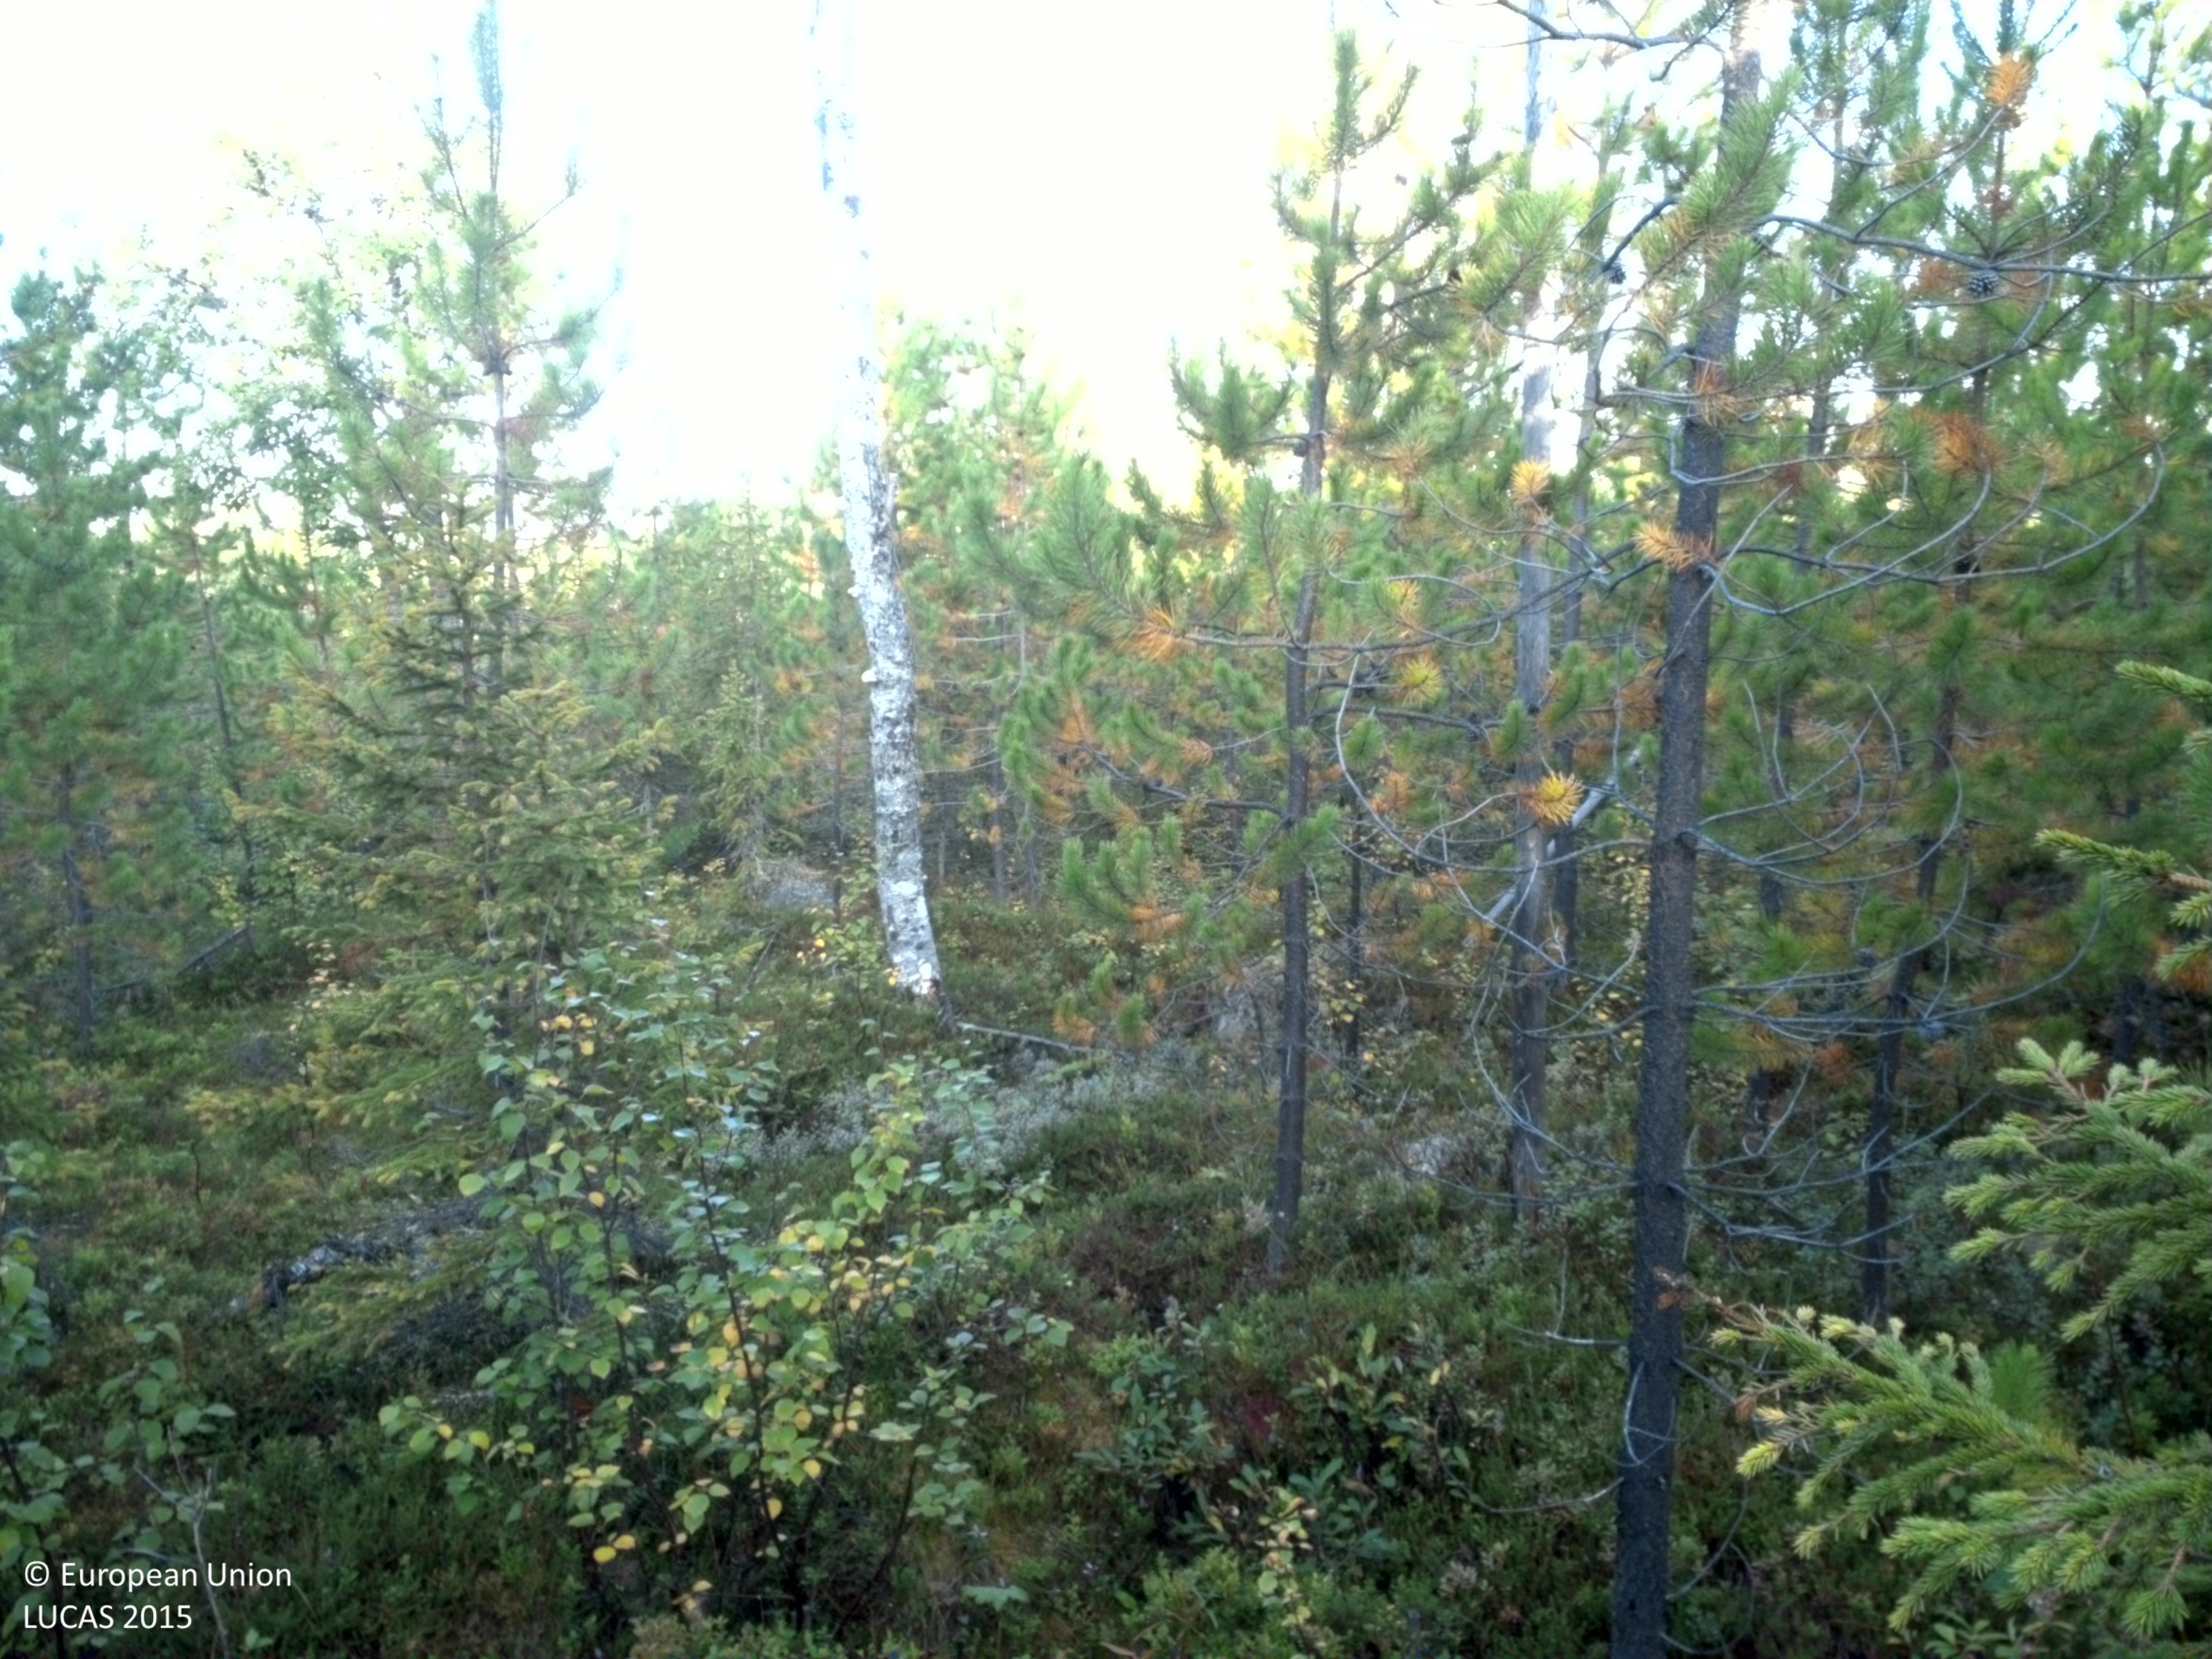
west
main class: Woodland
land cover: Pine dominated coniferous woodland
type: exotic forest
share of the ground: > 75 %
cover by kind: coniferous forest trees 75 %, shrubs 15 %, broadleaved forest trees 5 %, herbaceous plants 5 %
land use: Forestry
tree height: > 5 m
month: September
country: SE
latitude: 65.1773
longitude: 17.6262
